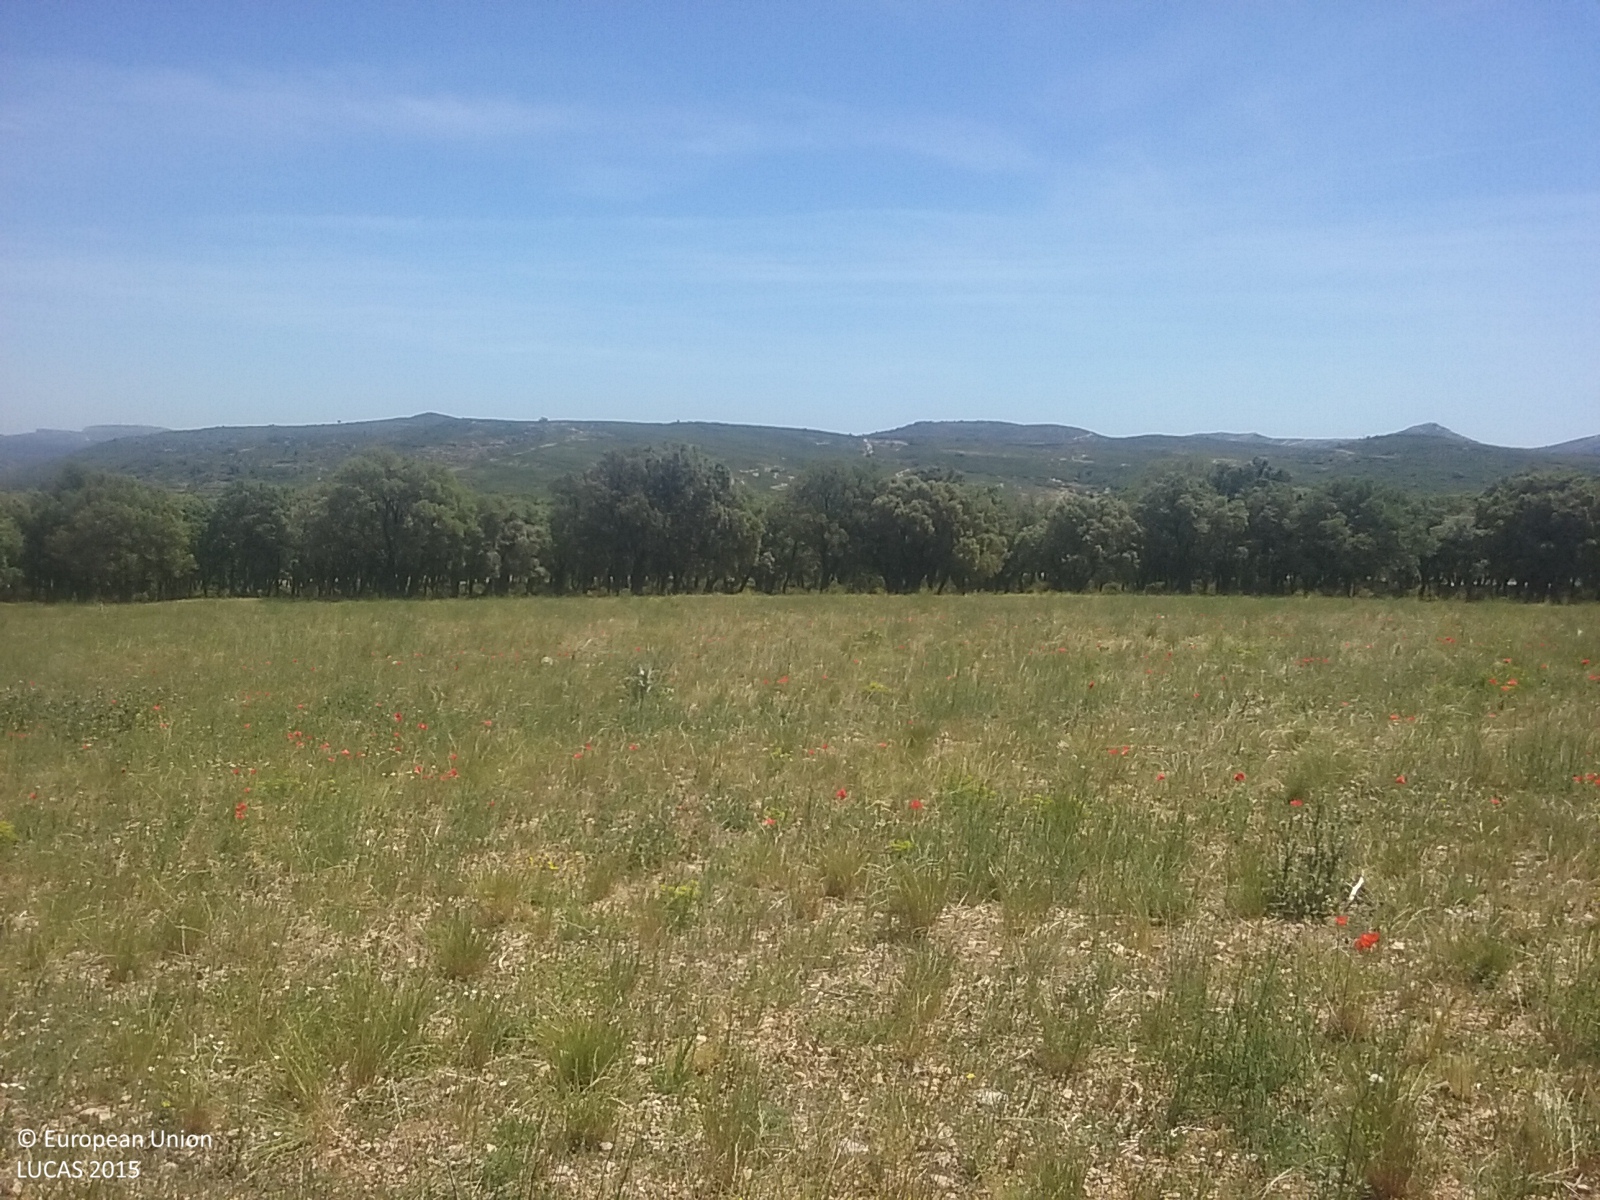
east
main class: Grassland
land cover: Spontaneously vegetated surfaces
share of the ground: > 75 %
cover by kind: herbaceous plants 95 %
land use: Fallow land
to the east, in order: Spontaneously vegetated surfaces; Broadleaved woodland; Dry stone walls; Tracks; Grass margins; Paved roads, cycling and walking lanes; Grass margins; Common wheat; Electric lines; Common wheat; Grass margins; Tracks; Nuts trees
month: May
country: ES
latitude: 40.5043
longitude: 0.0229
